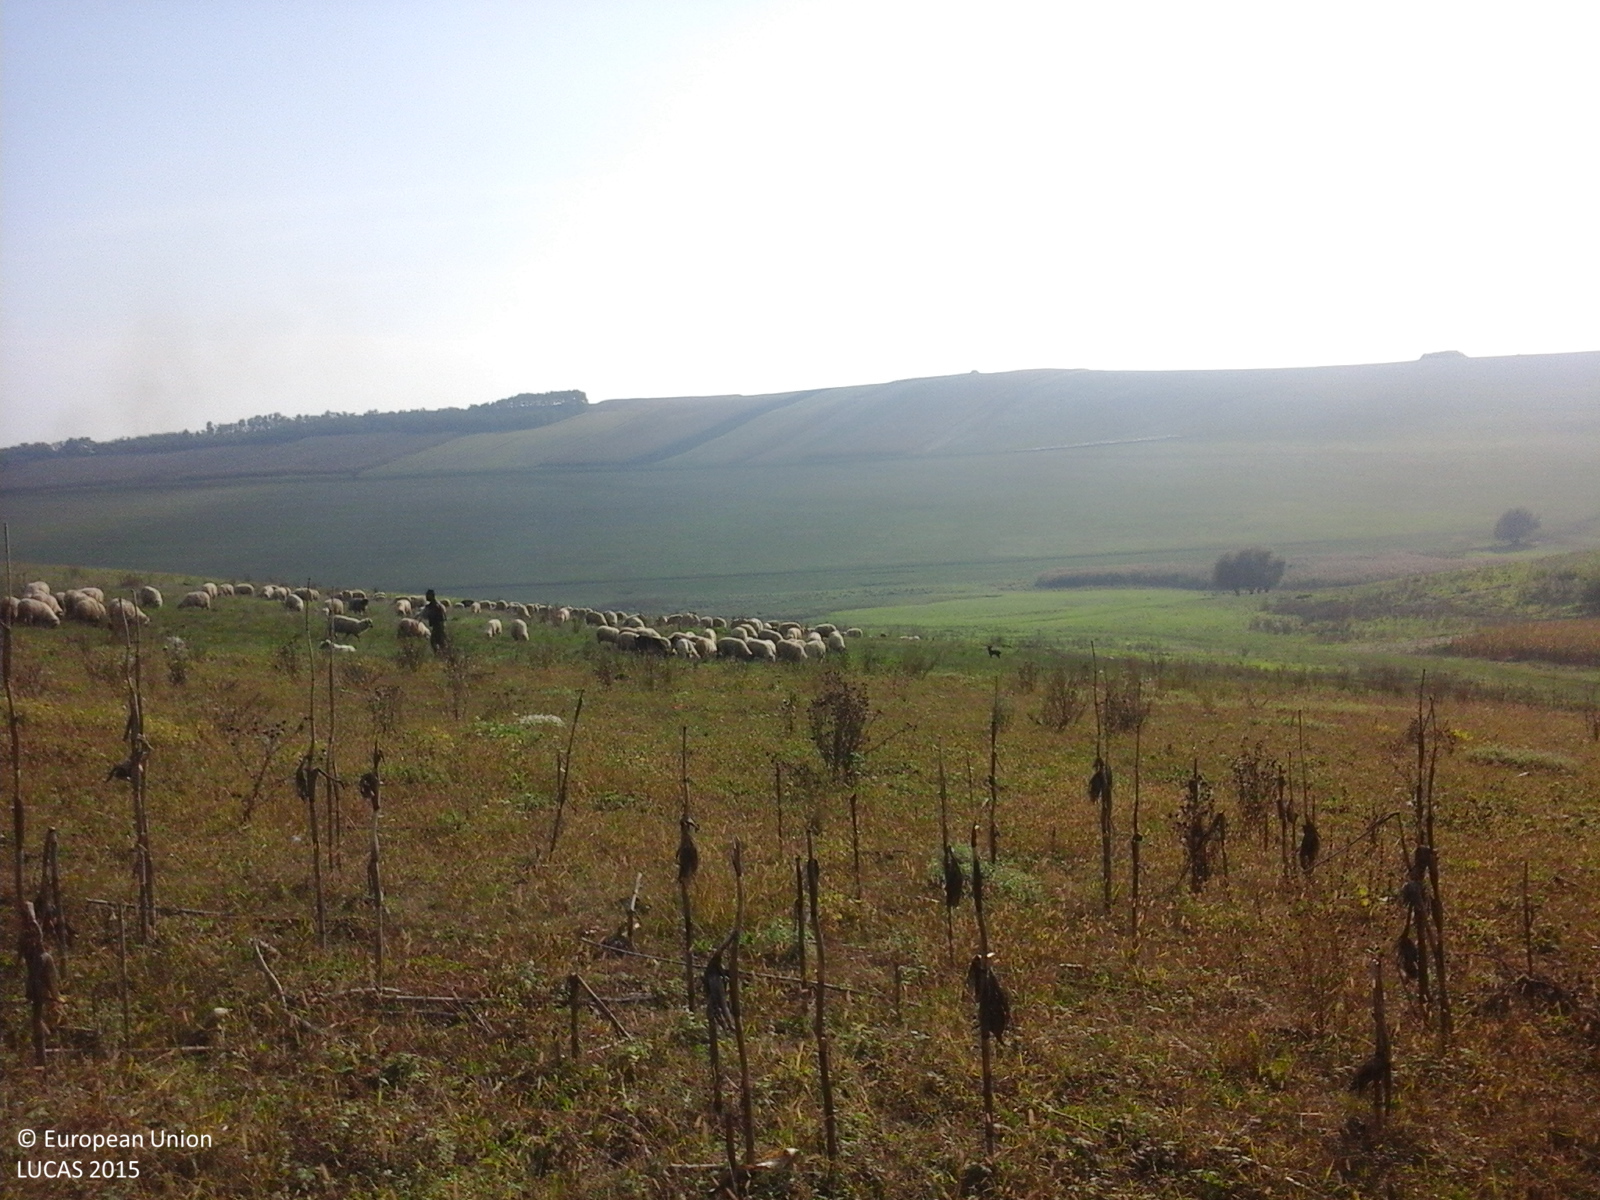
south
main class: Grassland
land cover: Spontaneously vegetated surfaces
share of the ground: > 75 %
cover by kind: herbaceous plants 100 %
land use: Agriculture (excluding fallow land and kitchen gardens)
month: October
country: RO
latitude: 46.6720
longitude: 24.2391
